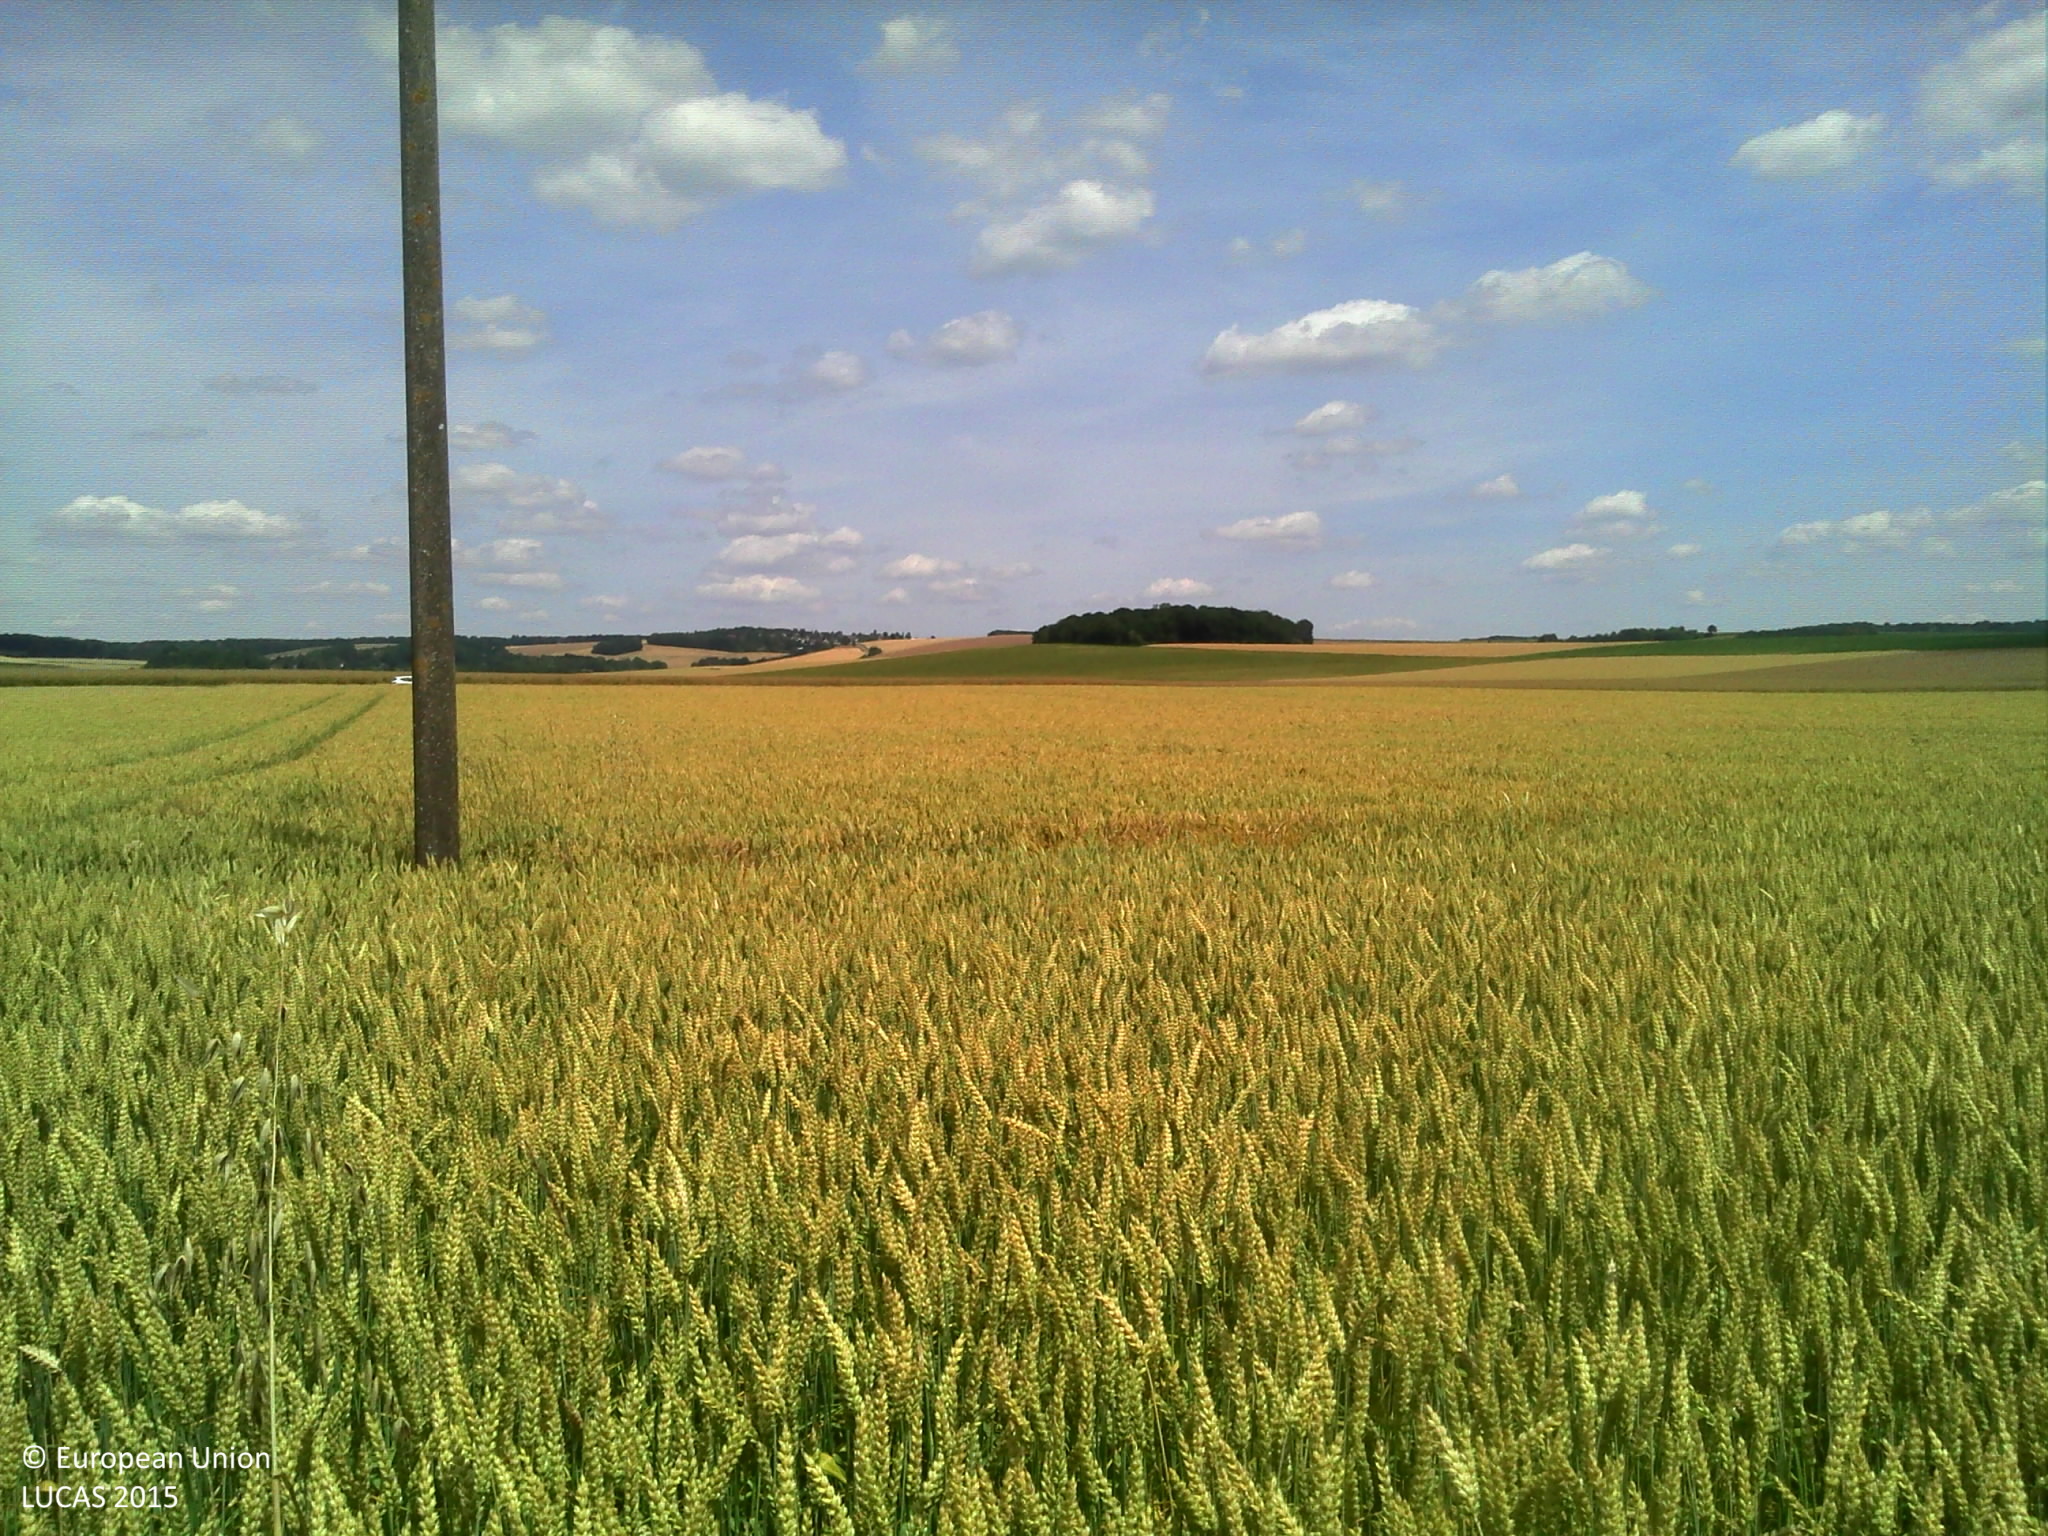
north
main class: Cropland
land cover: Common wheat
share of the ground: > 75 %
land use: Agriculture (excluding fallow land and kitchen gardens)
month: June
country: FR
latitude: 47.9969
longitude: 3.5220
